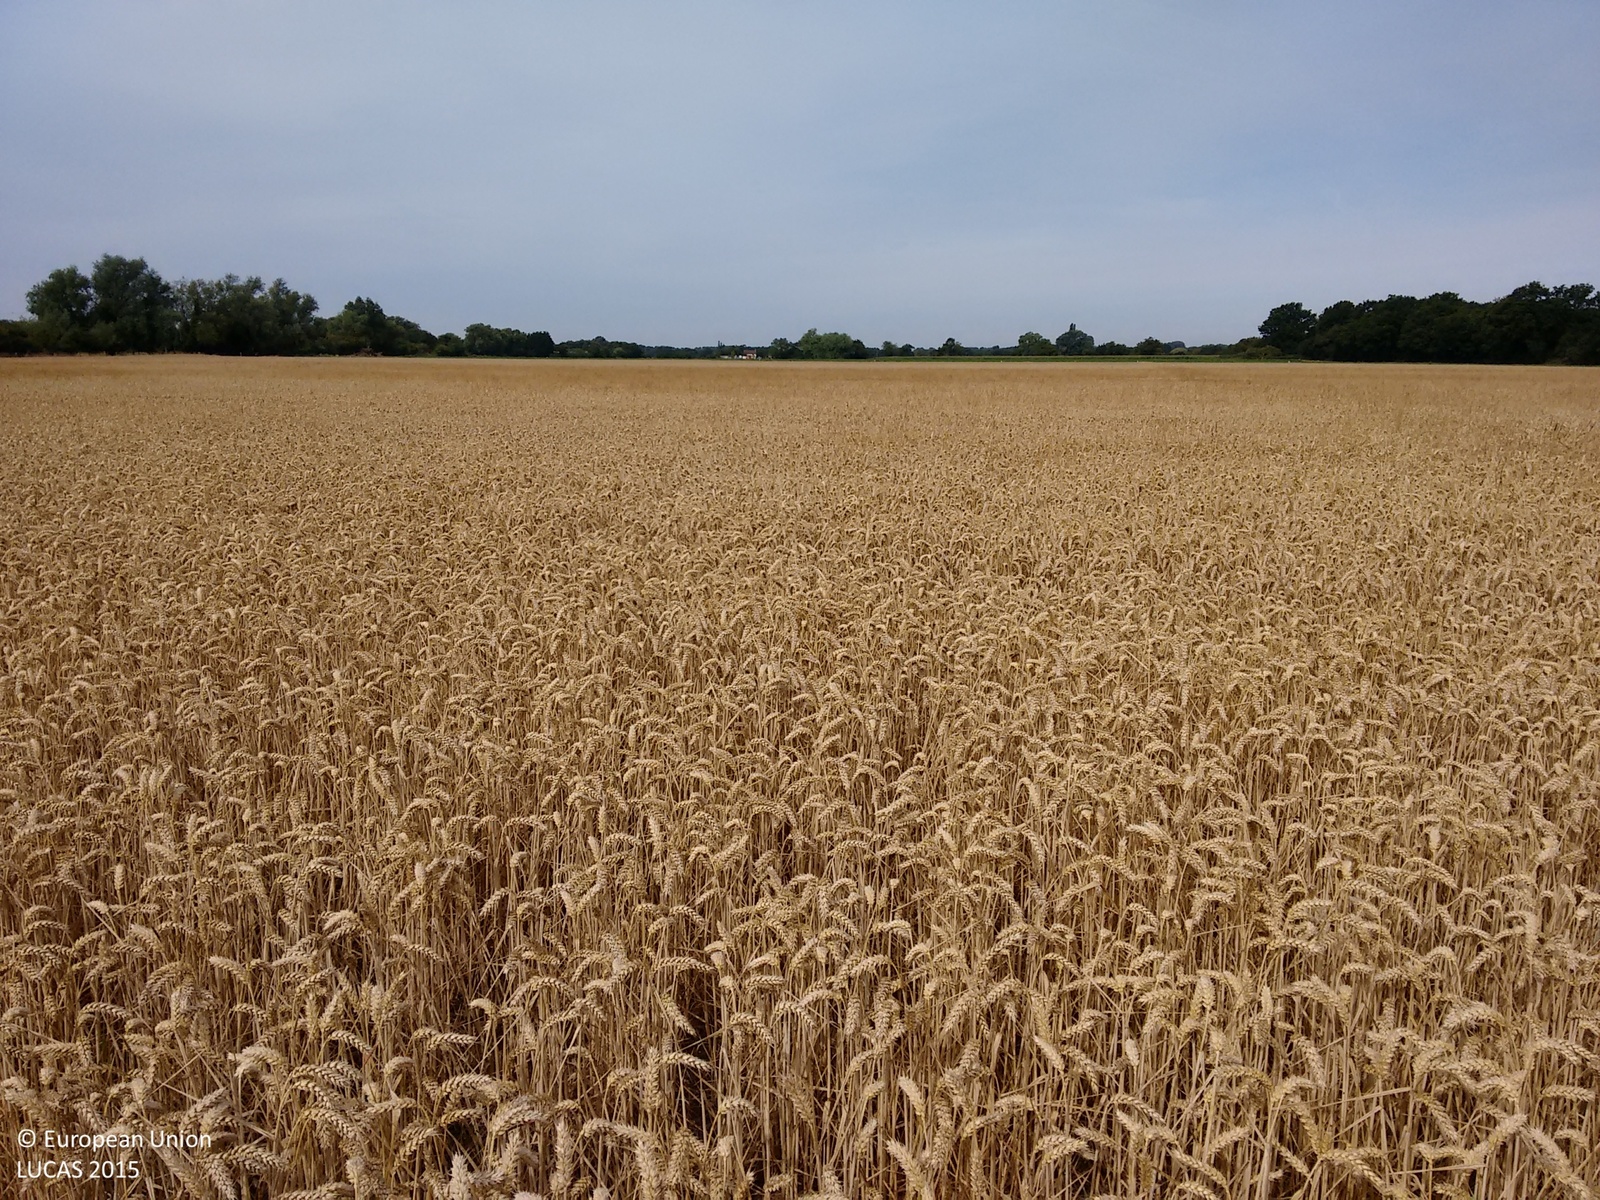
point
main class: Cropland
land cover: Common wheat
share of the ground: > 75 %
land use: Agriculture (excluding fallow land and kitchen gardens)
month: August
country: GB
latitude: 52.5715
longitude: 0.4553
